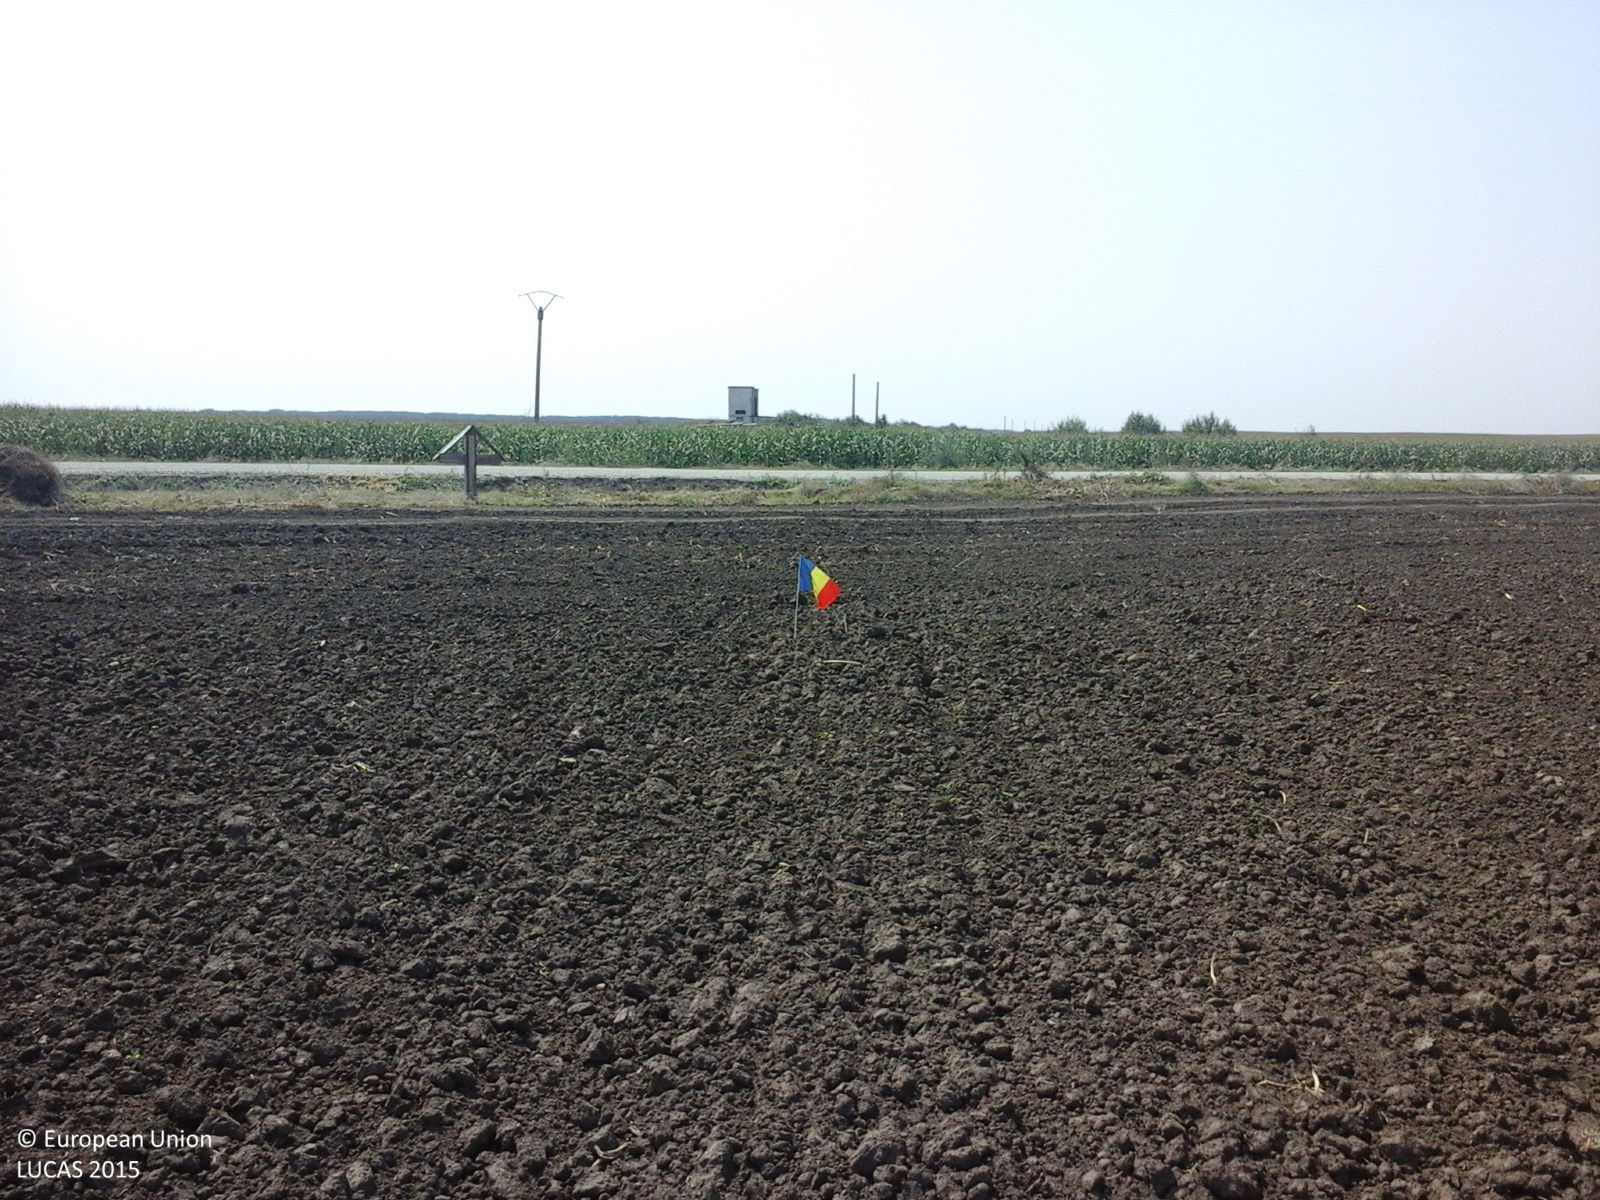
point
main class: Cropland
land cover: Common wheat
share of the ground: < 10 %
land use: Agriculture (excluding fallow land and kitchen gardens)
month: July
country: RO
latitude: 44.5716
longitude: 26.7836
